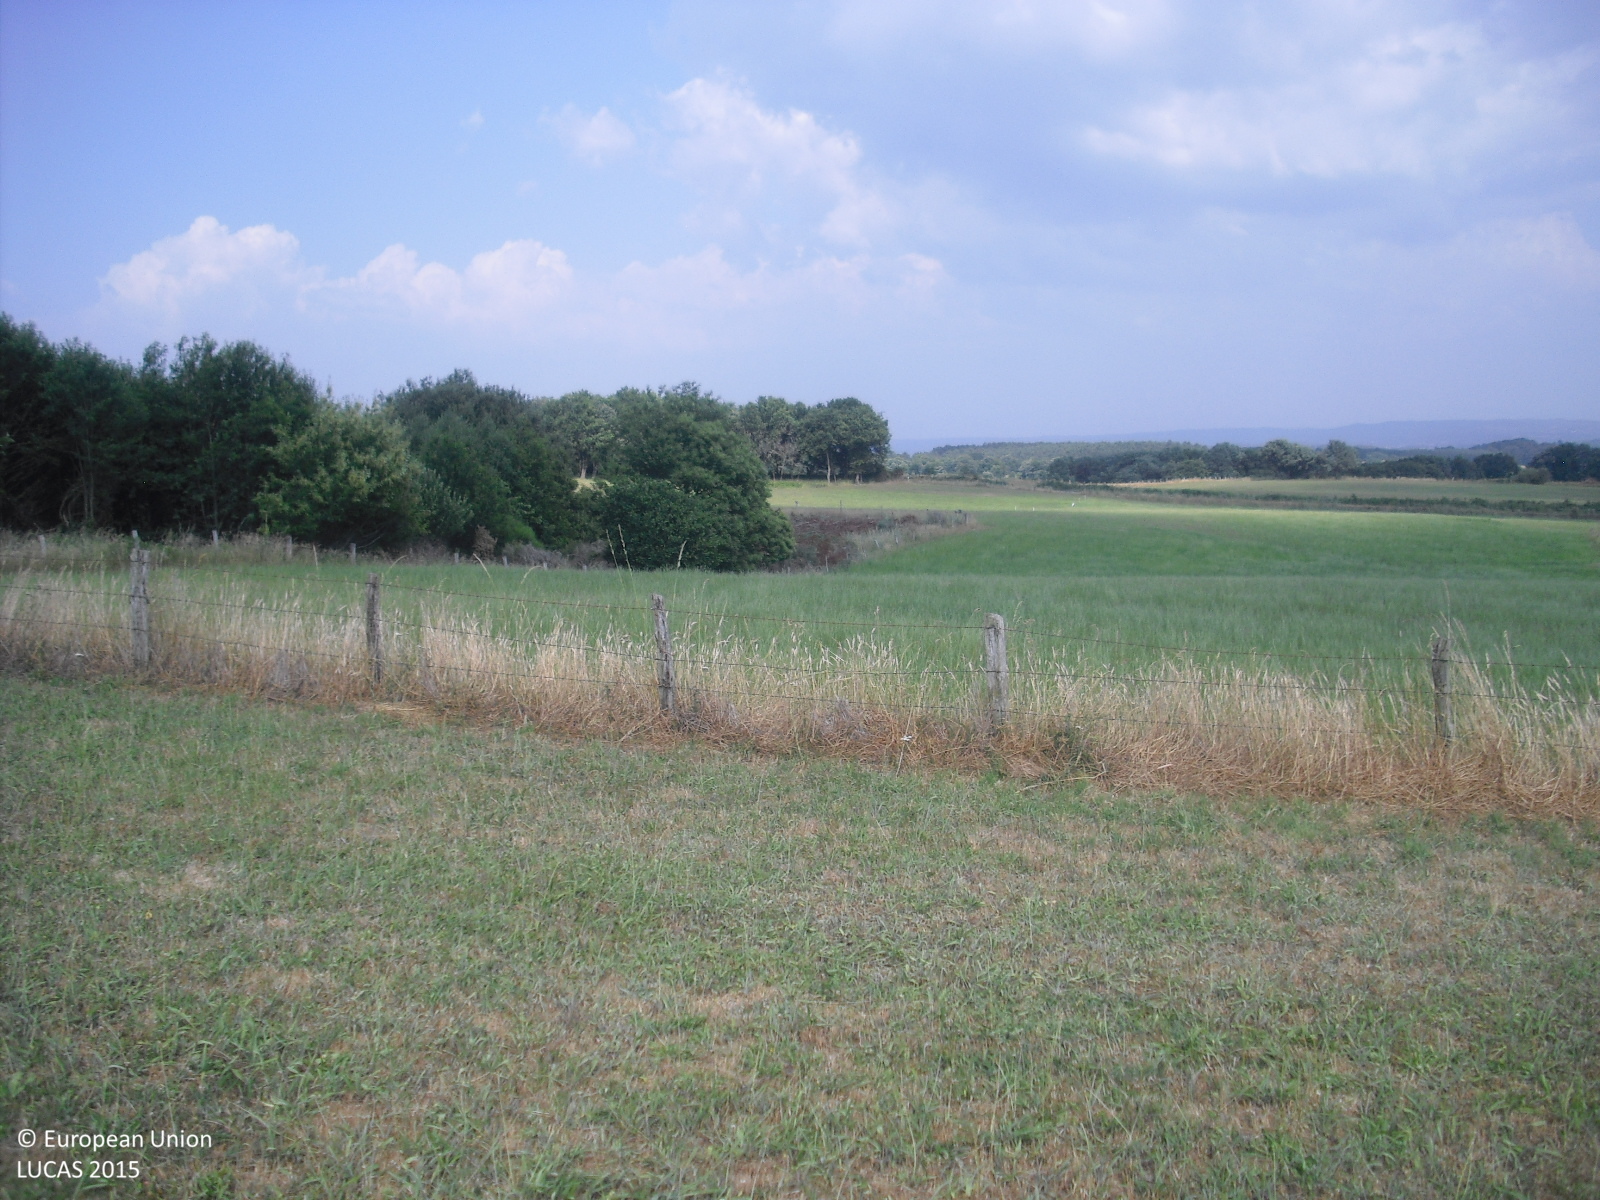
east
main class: Cropland
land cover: Temporary grasslands
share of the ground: > 75 %
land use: Agriculture (excluding fallow land and kitchen gardens)
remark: Clear cut
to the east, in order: Temporary grasslands; Fences; Temporary grasslands; Fences; Spontaneously vegetated surfaces; Fences; Temporary grasslands
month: June
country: ES
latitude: 42.6223
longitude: -7.8446
